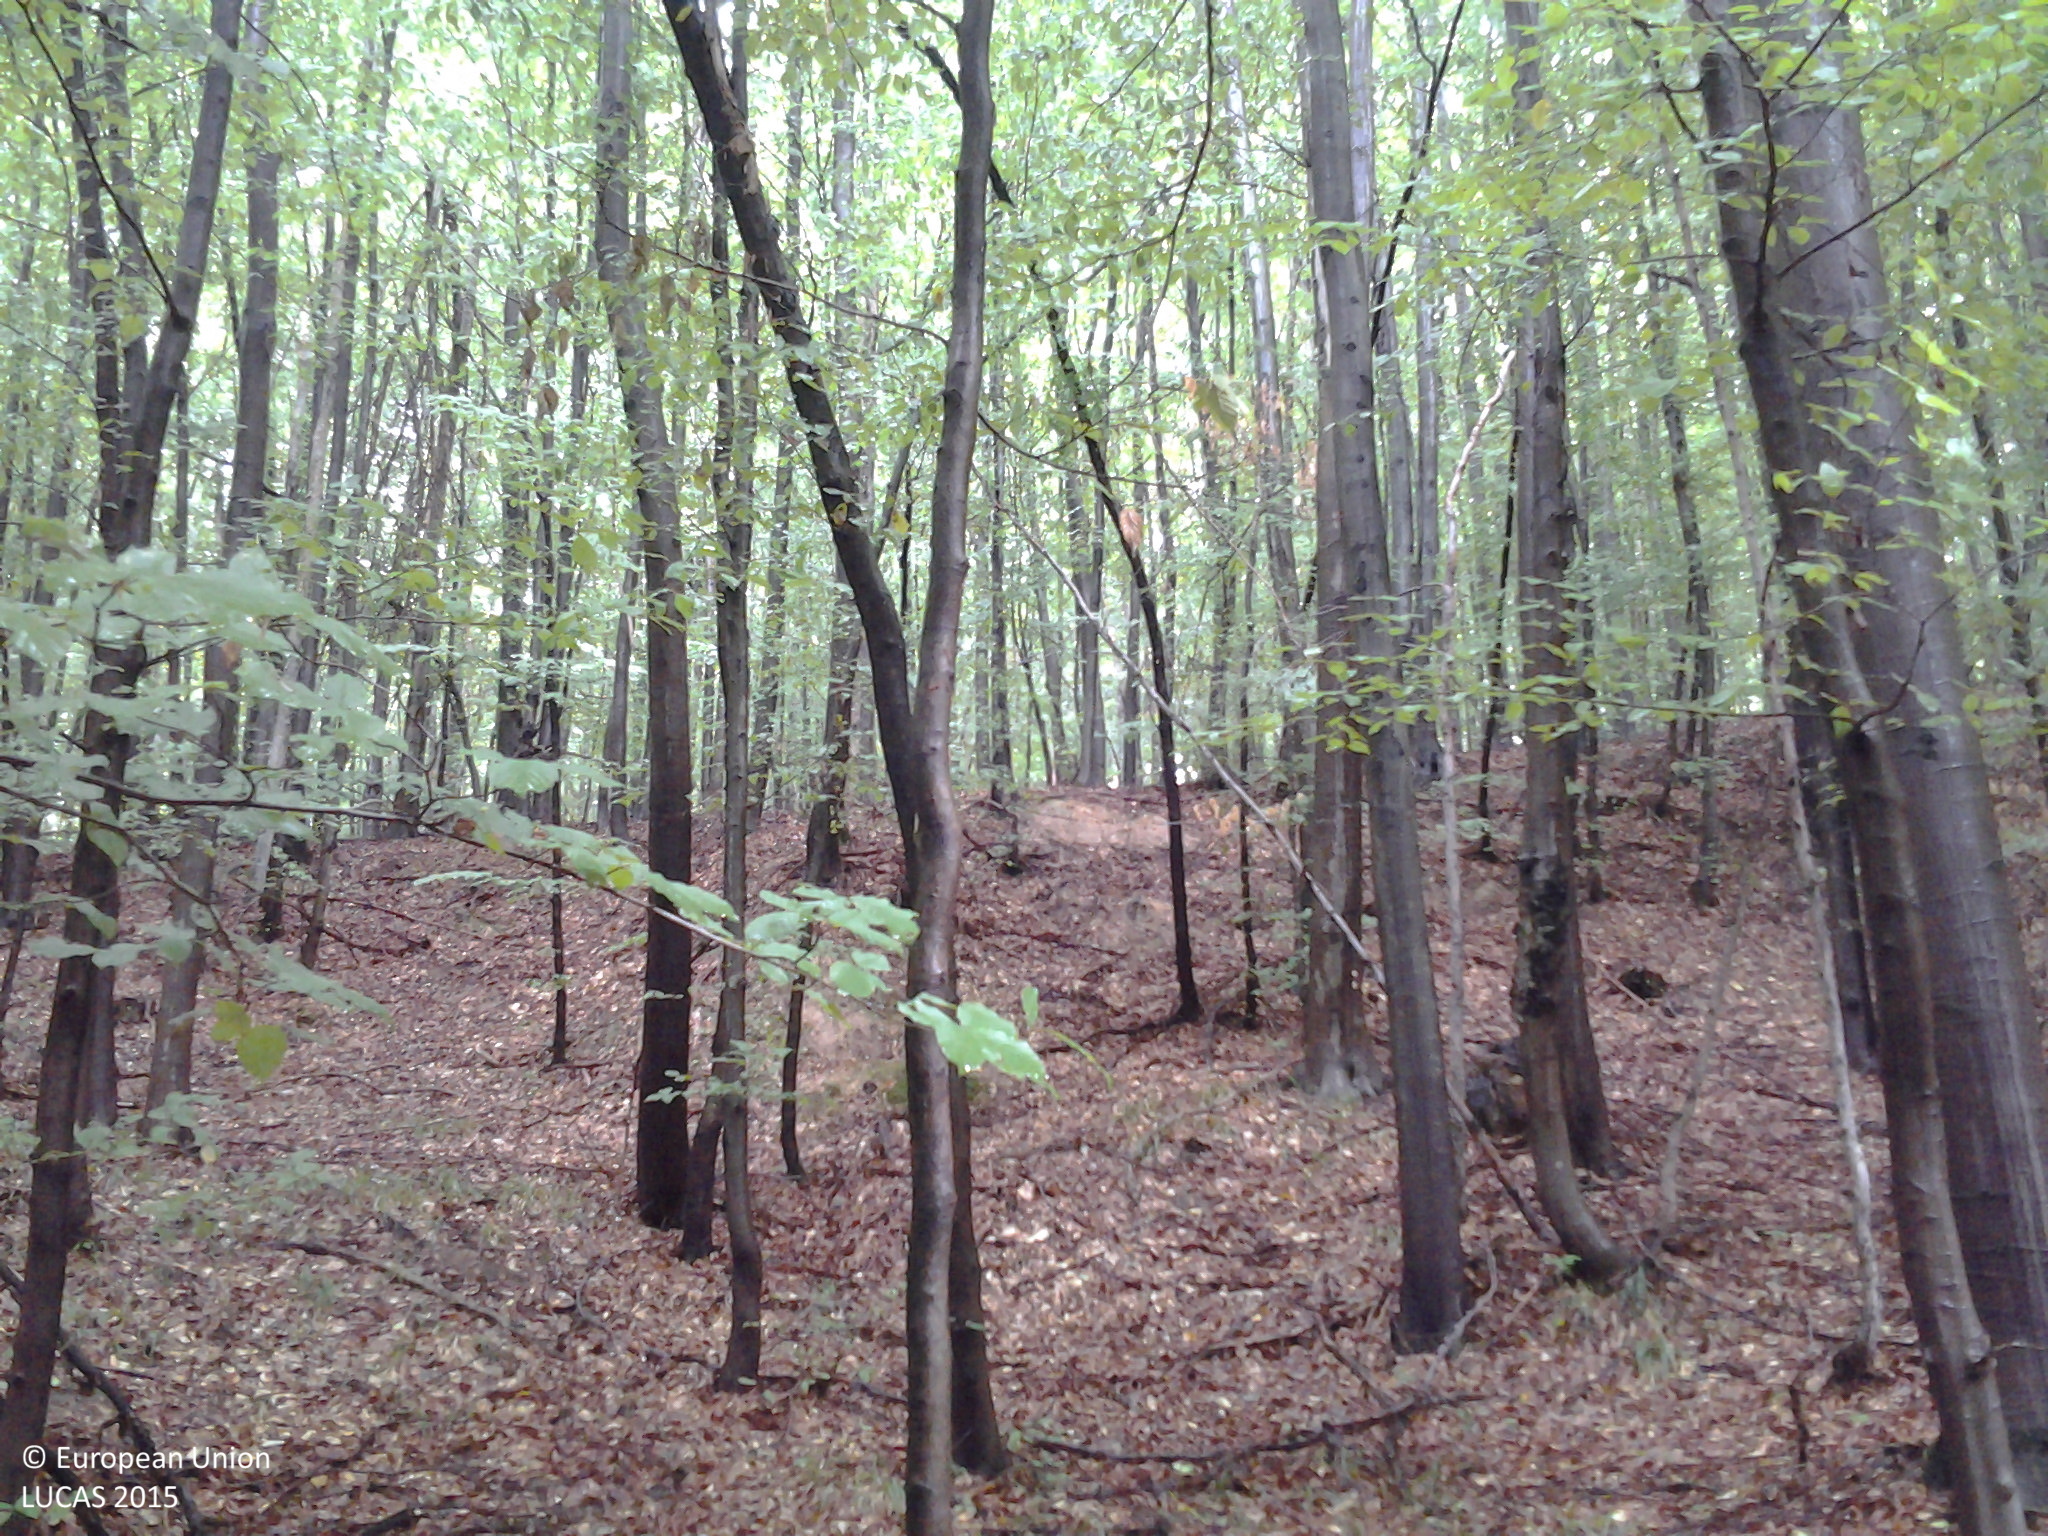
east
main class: Woodland
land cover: Broadleaved woodland
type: beech forest
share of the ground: > 75 %
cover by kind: broadleaved forest trees 100 %
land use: Forestry
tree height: > 5 m
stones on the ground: 10 - 25 %
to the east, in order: Broadleaved woodland; Tracks; Broadleaved woodland
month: September
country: RO
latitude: 46.9797
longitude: 22.6639
